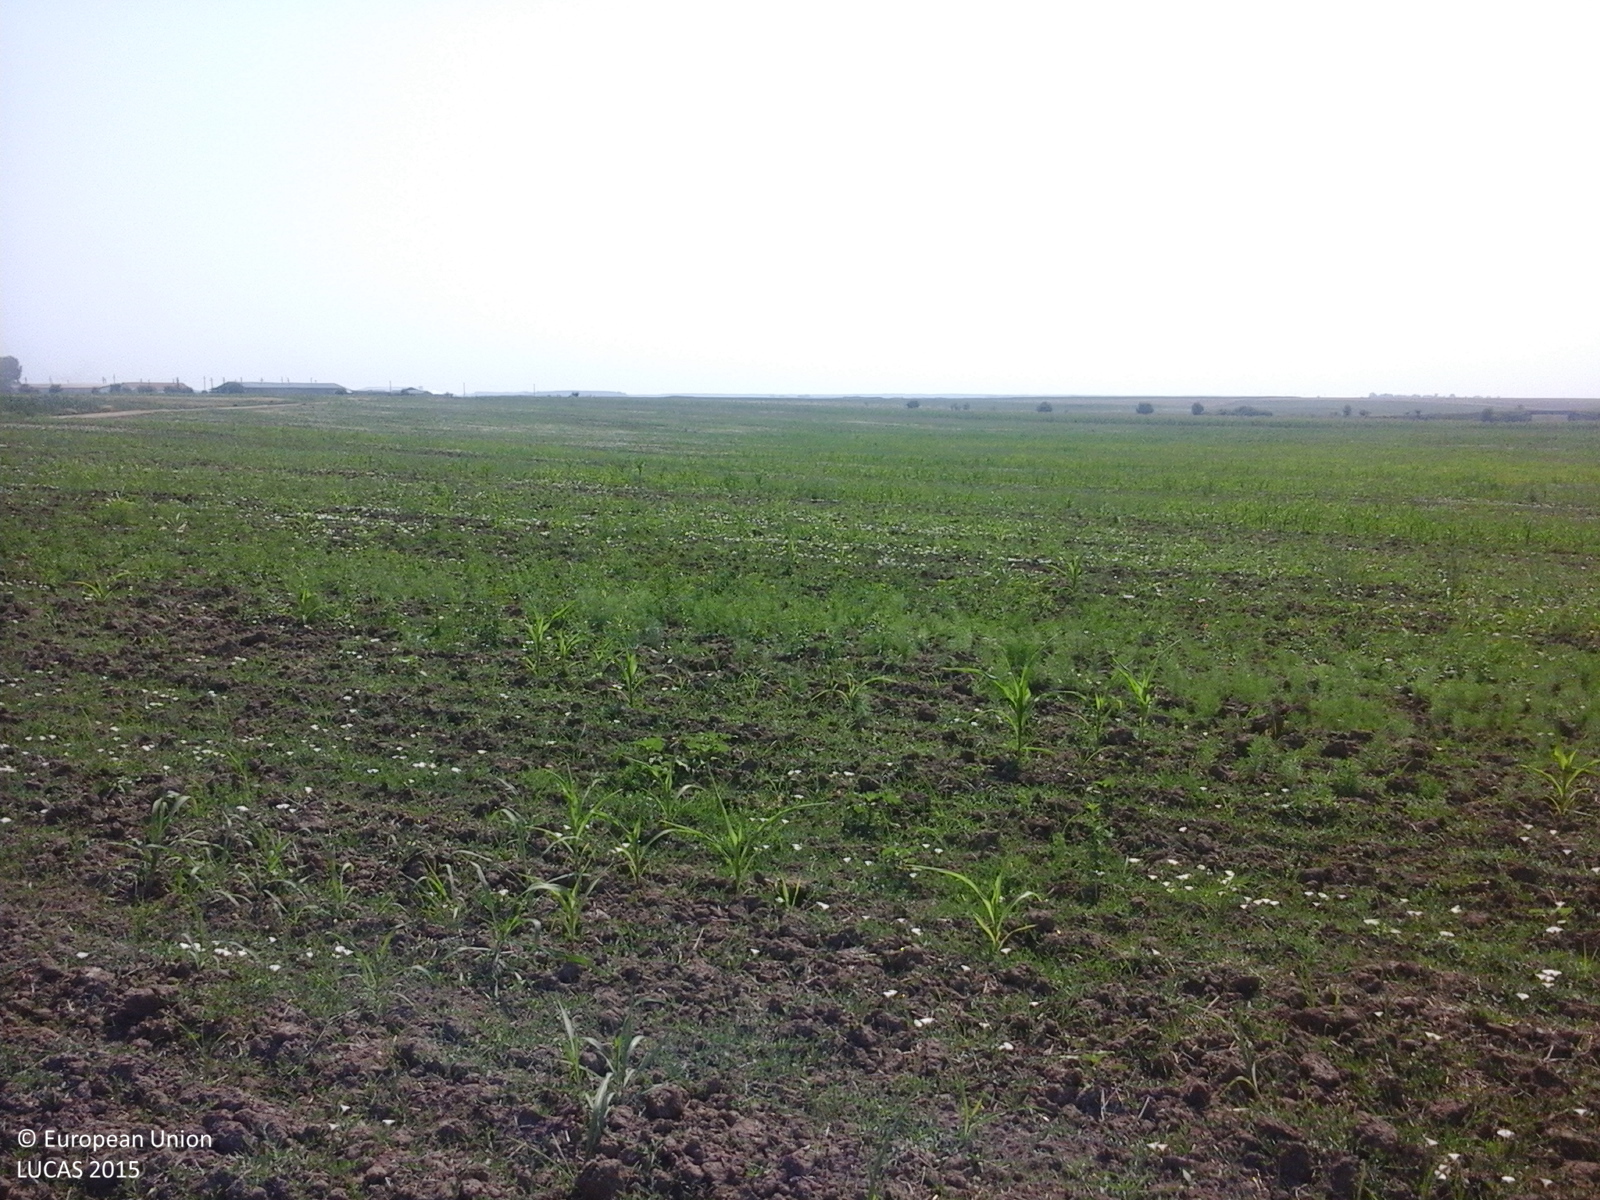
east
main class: Grassland
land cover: Spontaneously vegetated surfaces
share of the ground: < 10 %
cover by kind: herbaceous plants 100 %
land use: Fallow land
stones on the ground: < 10 %
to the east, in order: Spontaneously vegetated surfaces
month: July
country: RO
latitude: 44.5194
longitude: 25.4782
